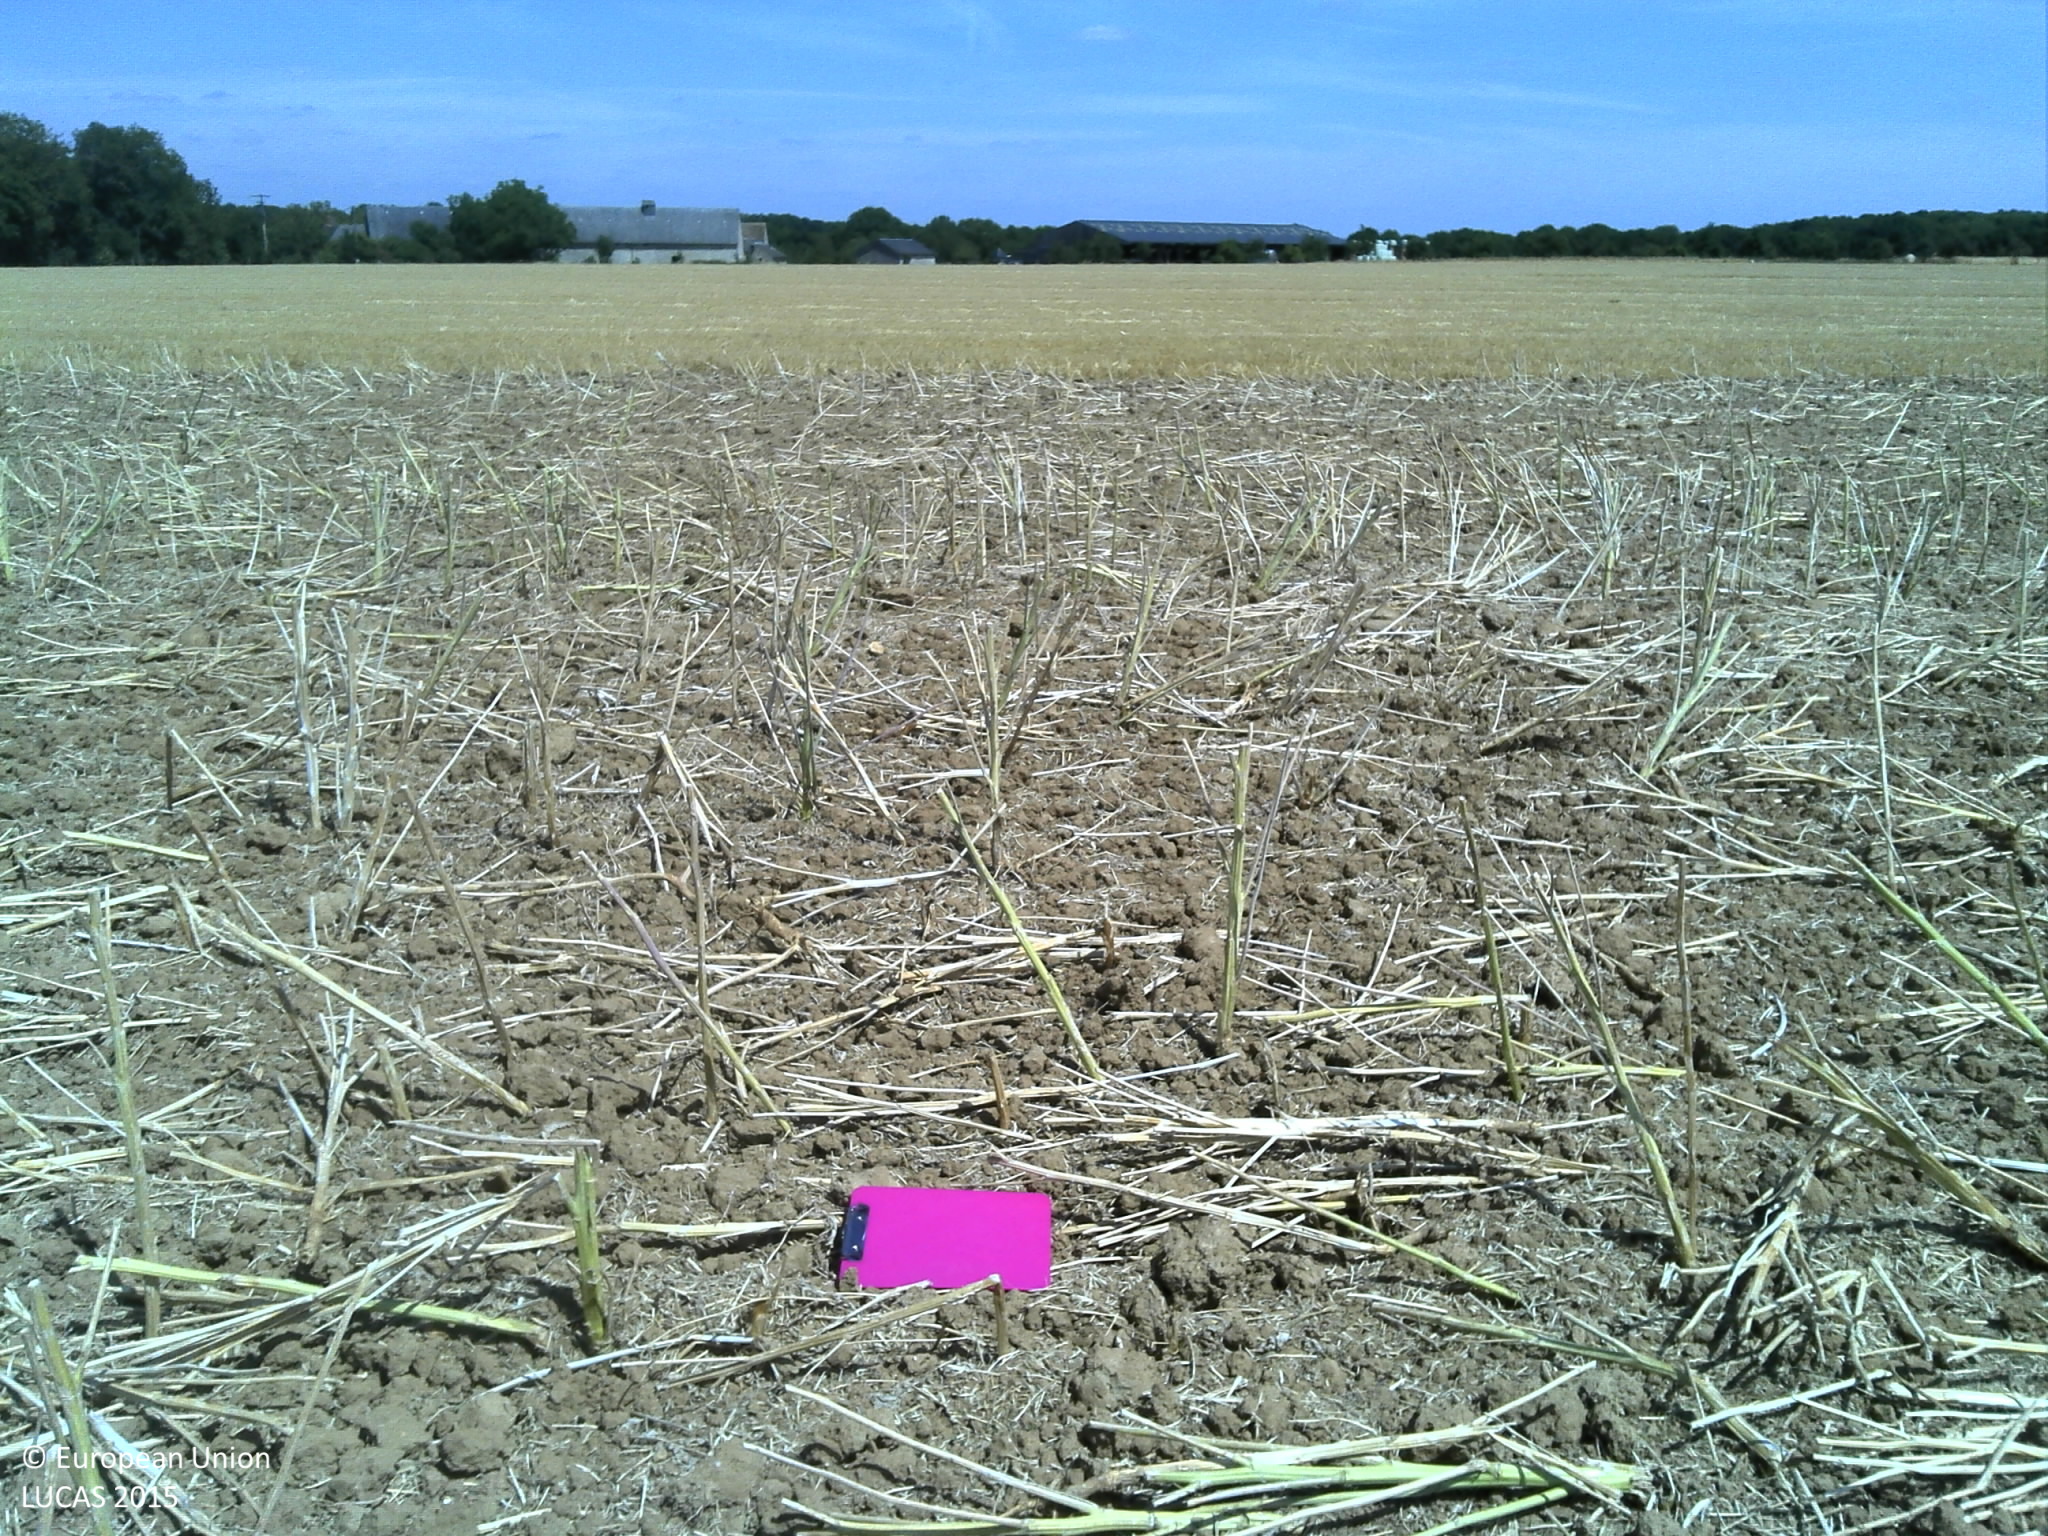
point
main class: Cropland
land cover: Rape and turnip rape
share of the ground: 10 - 25 %
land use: Agriculture (excluding fallow land and kitchen gardens)
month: July
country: FR
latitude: 48.5062
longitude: 1.9325
